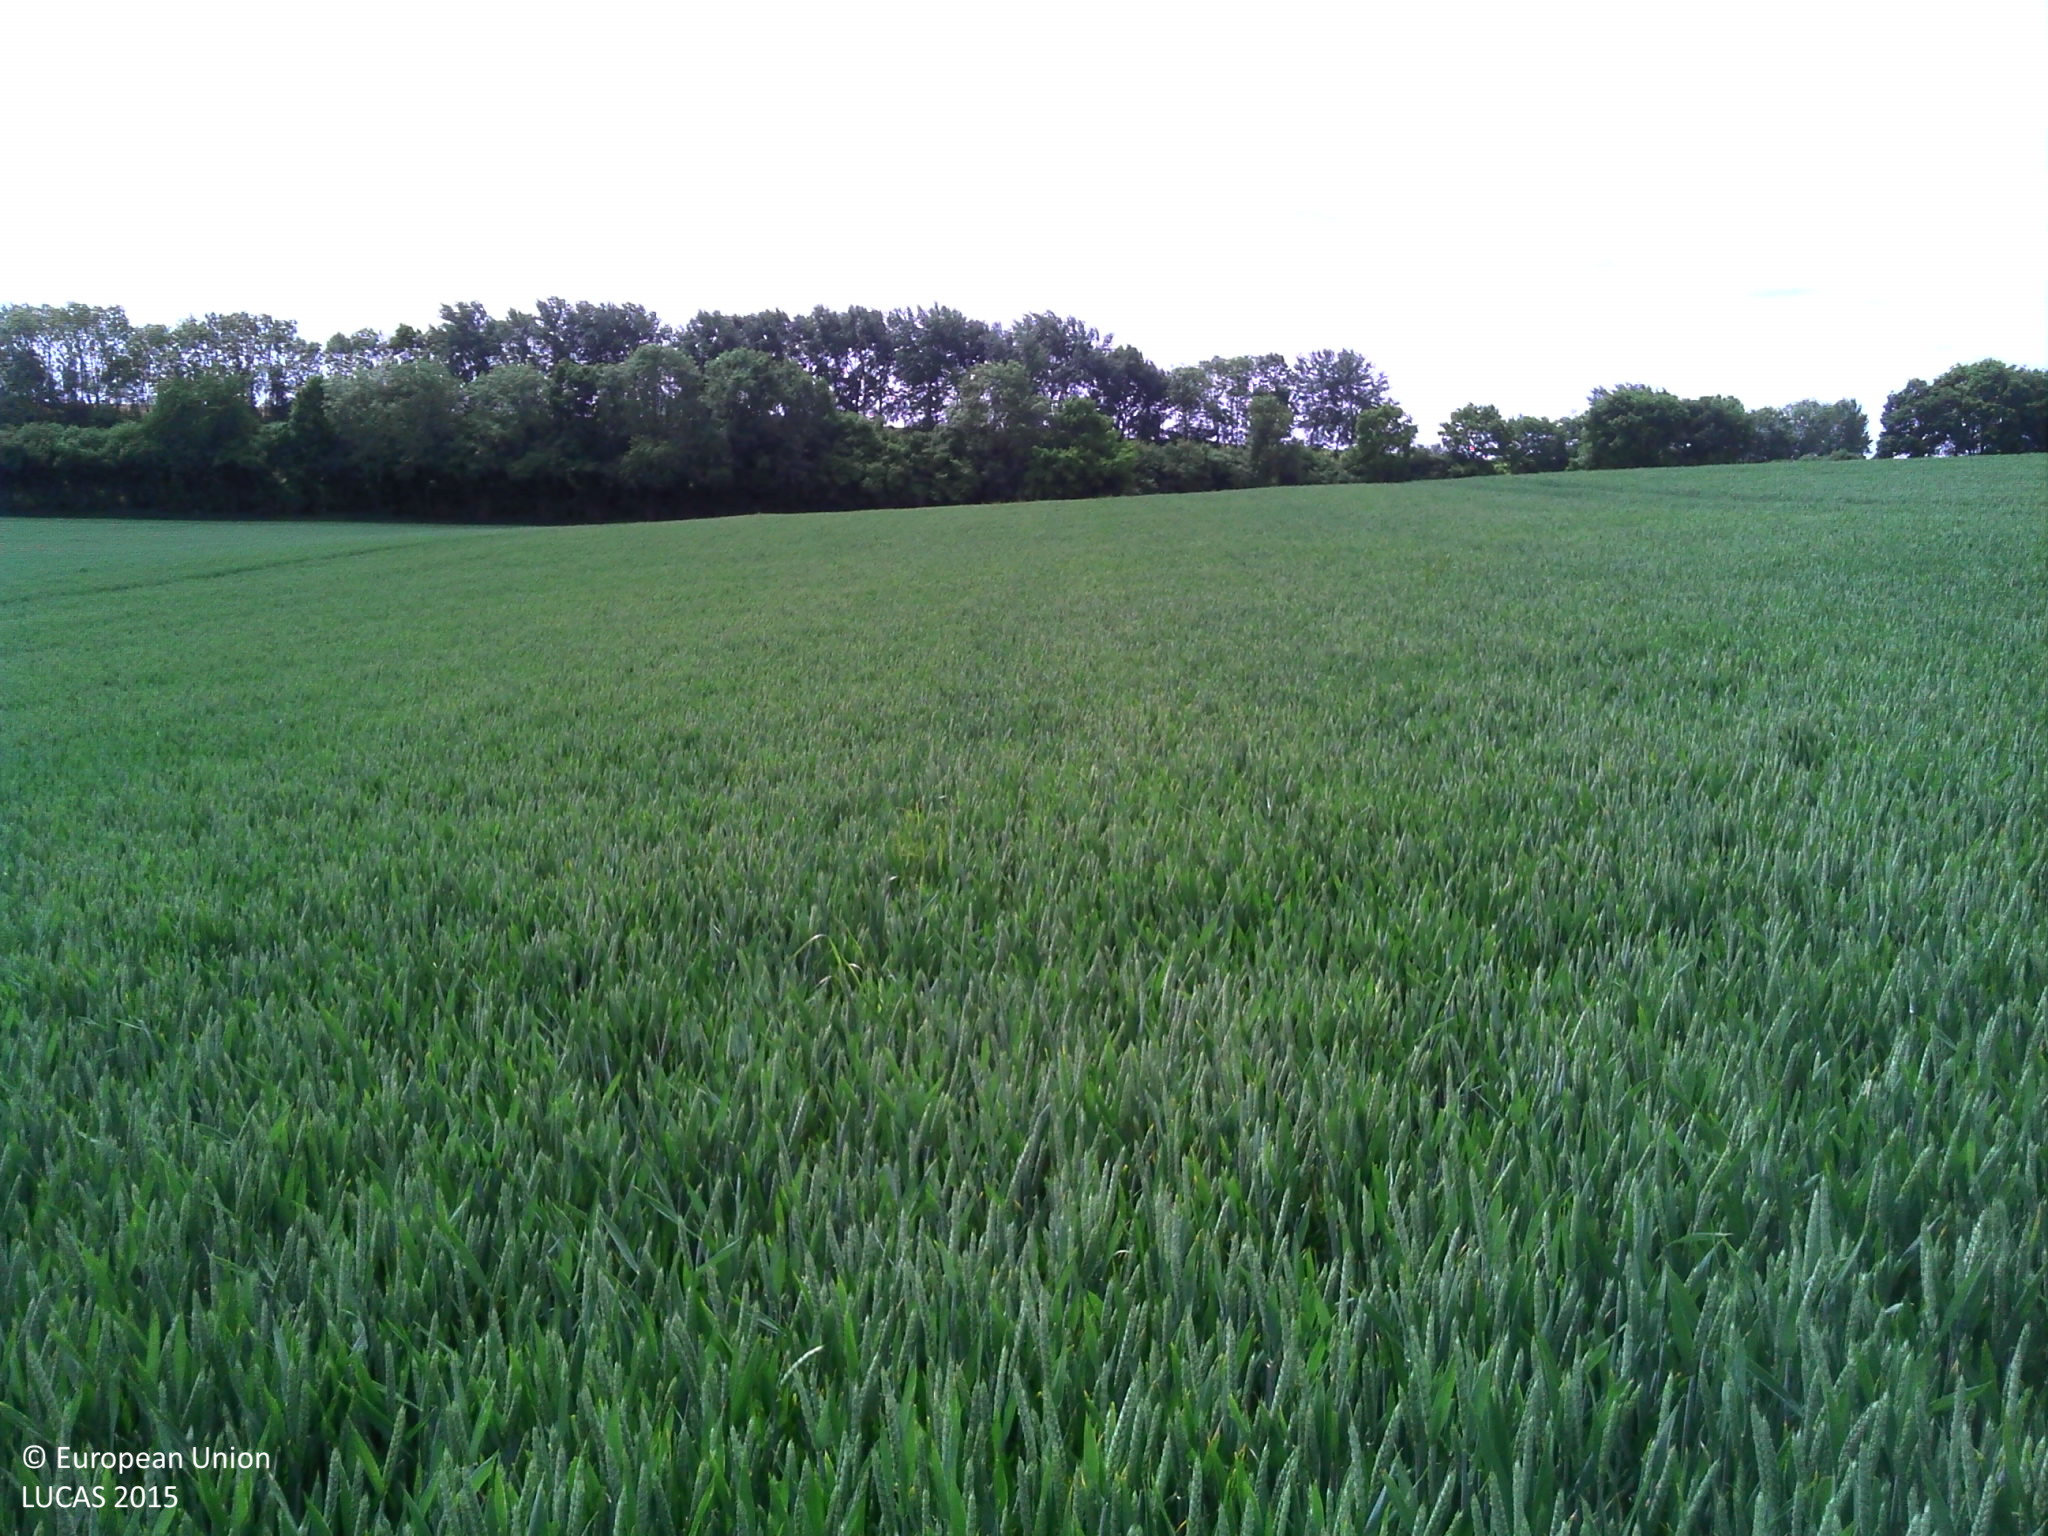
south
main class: Cropland
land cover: Common wheat
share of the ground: > 75 %
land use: Agriculture (excluding fallow land and kitchen gardens)
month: May
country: FR
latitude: 49.8005
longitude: 3.1973
